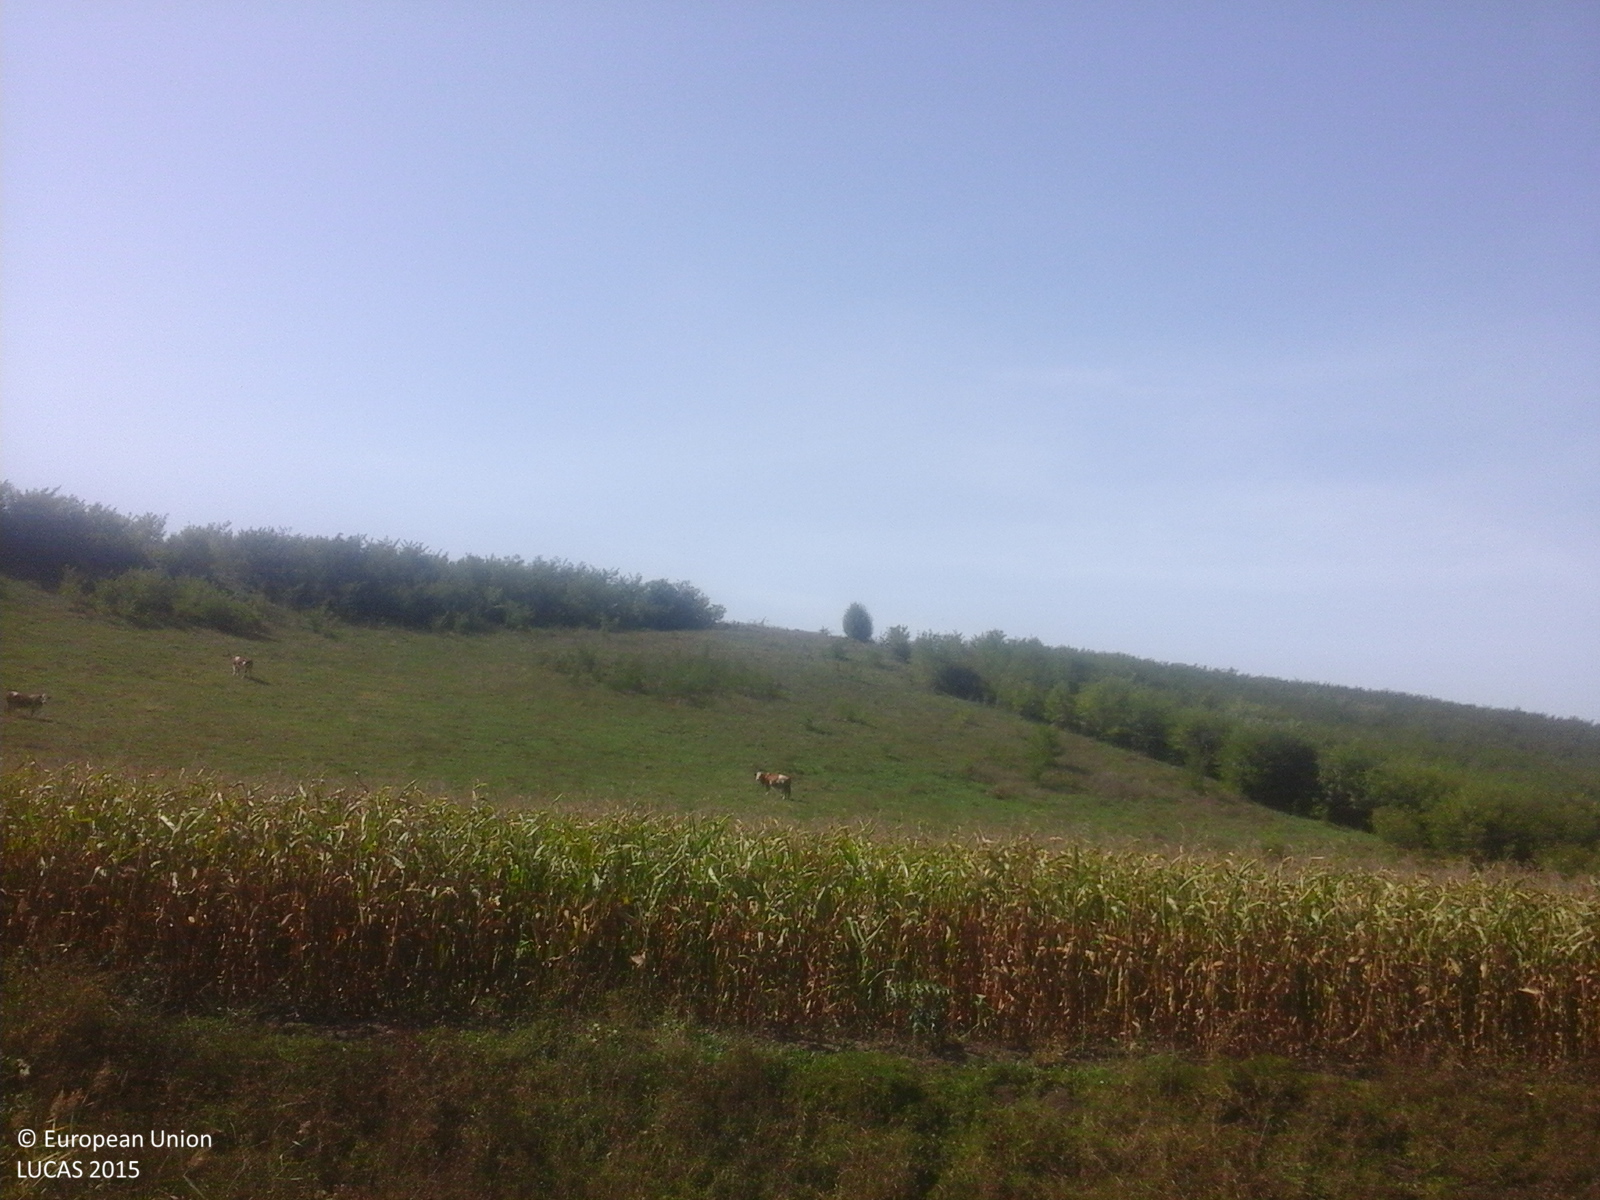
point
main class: Cropland
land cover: Maize
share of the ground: > 75 %
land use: Agriculture (excluding fallow land and kitchen gardens)
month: September
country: RO
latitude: 46.7249
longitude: 24.2536
